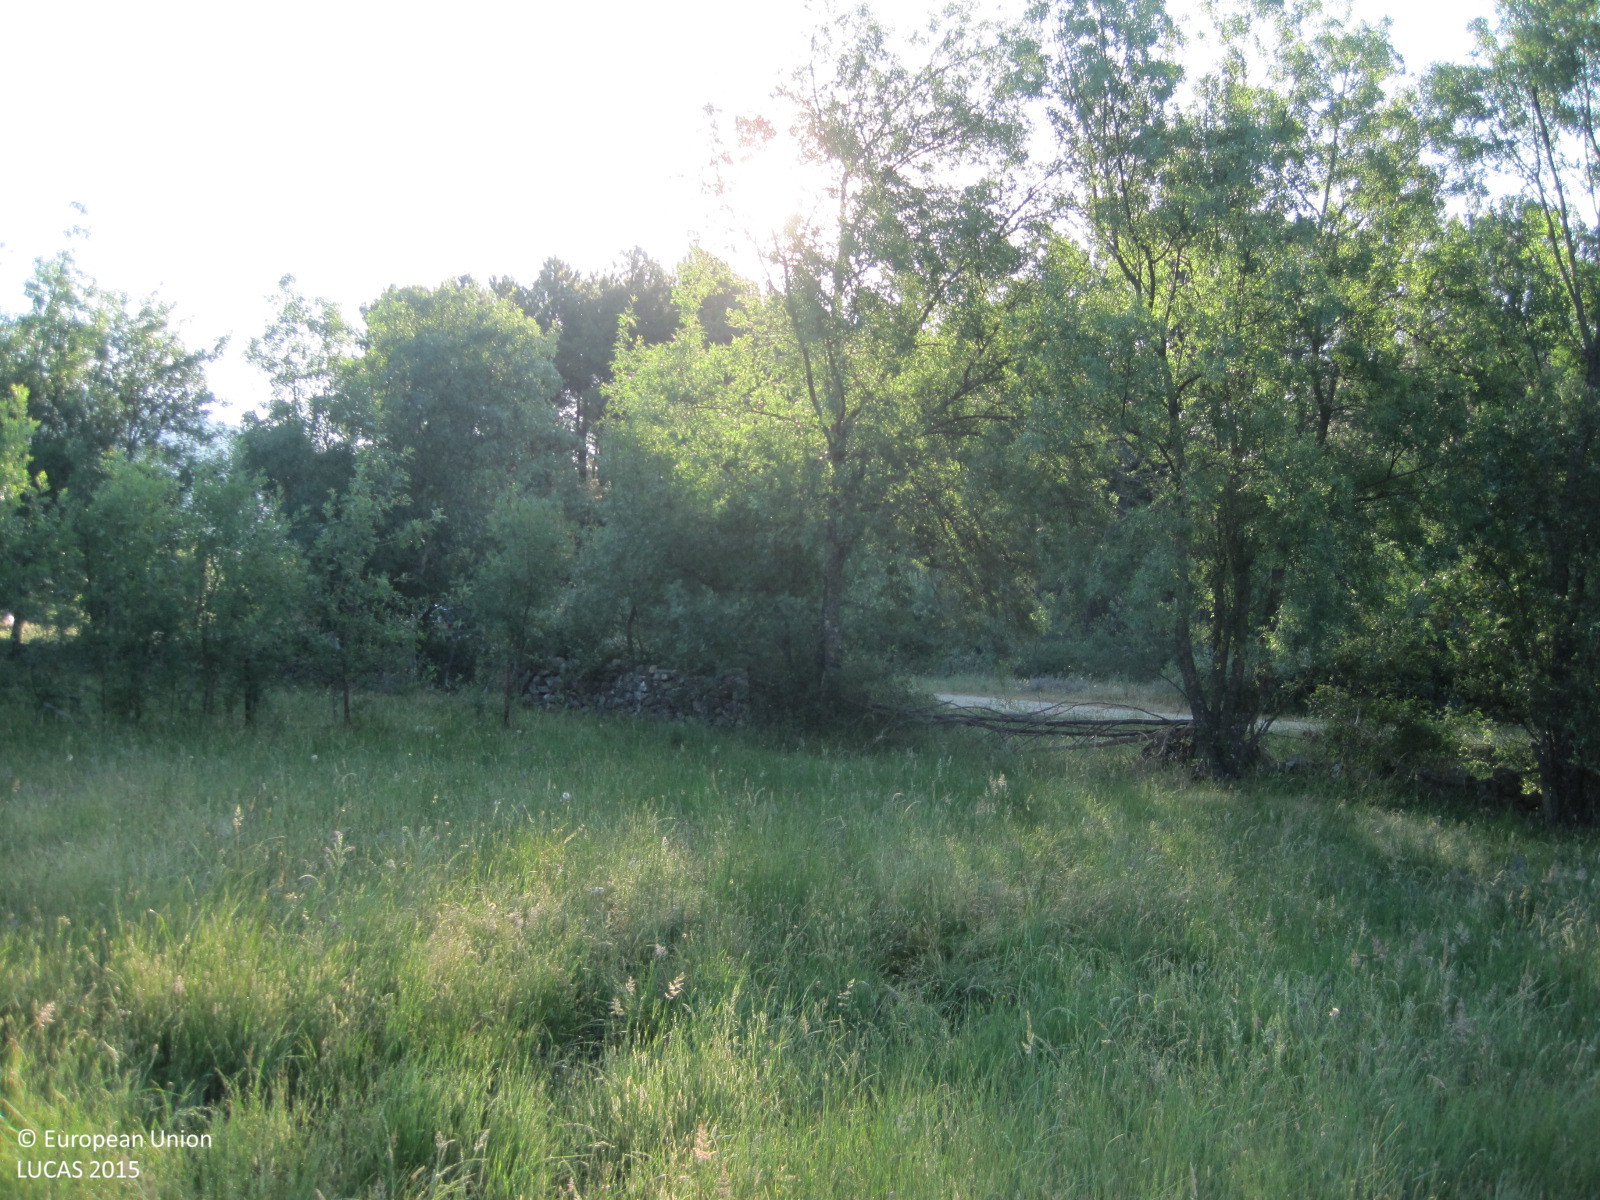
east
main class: Grassland
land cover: Grassland without tree/shrub cover
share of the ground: > 75 %
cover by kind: herbaceous plants 100 %
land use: Agriculture (excluding fallow land and kitchen gardens)
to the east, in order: Grassland without tree/shrub cover; Abandoned hedges; Dry stone walls; Grass margins; Tracks; Grass margins; Shrubland with sparse tree cover; Electric lines; Shrubland with sparse tree cover; Dry stone walls; Pine dominated mixed woodland; Dry stone walls; Grass margins; Tracks; Grass margins; Shruby margins; Rivers and streams; Shruby margins; Dry stone walls; Shruby margins; Grassland without tree/shrub cover
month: May
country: ES
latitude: 40.2990
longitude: -4.7694
